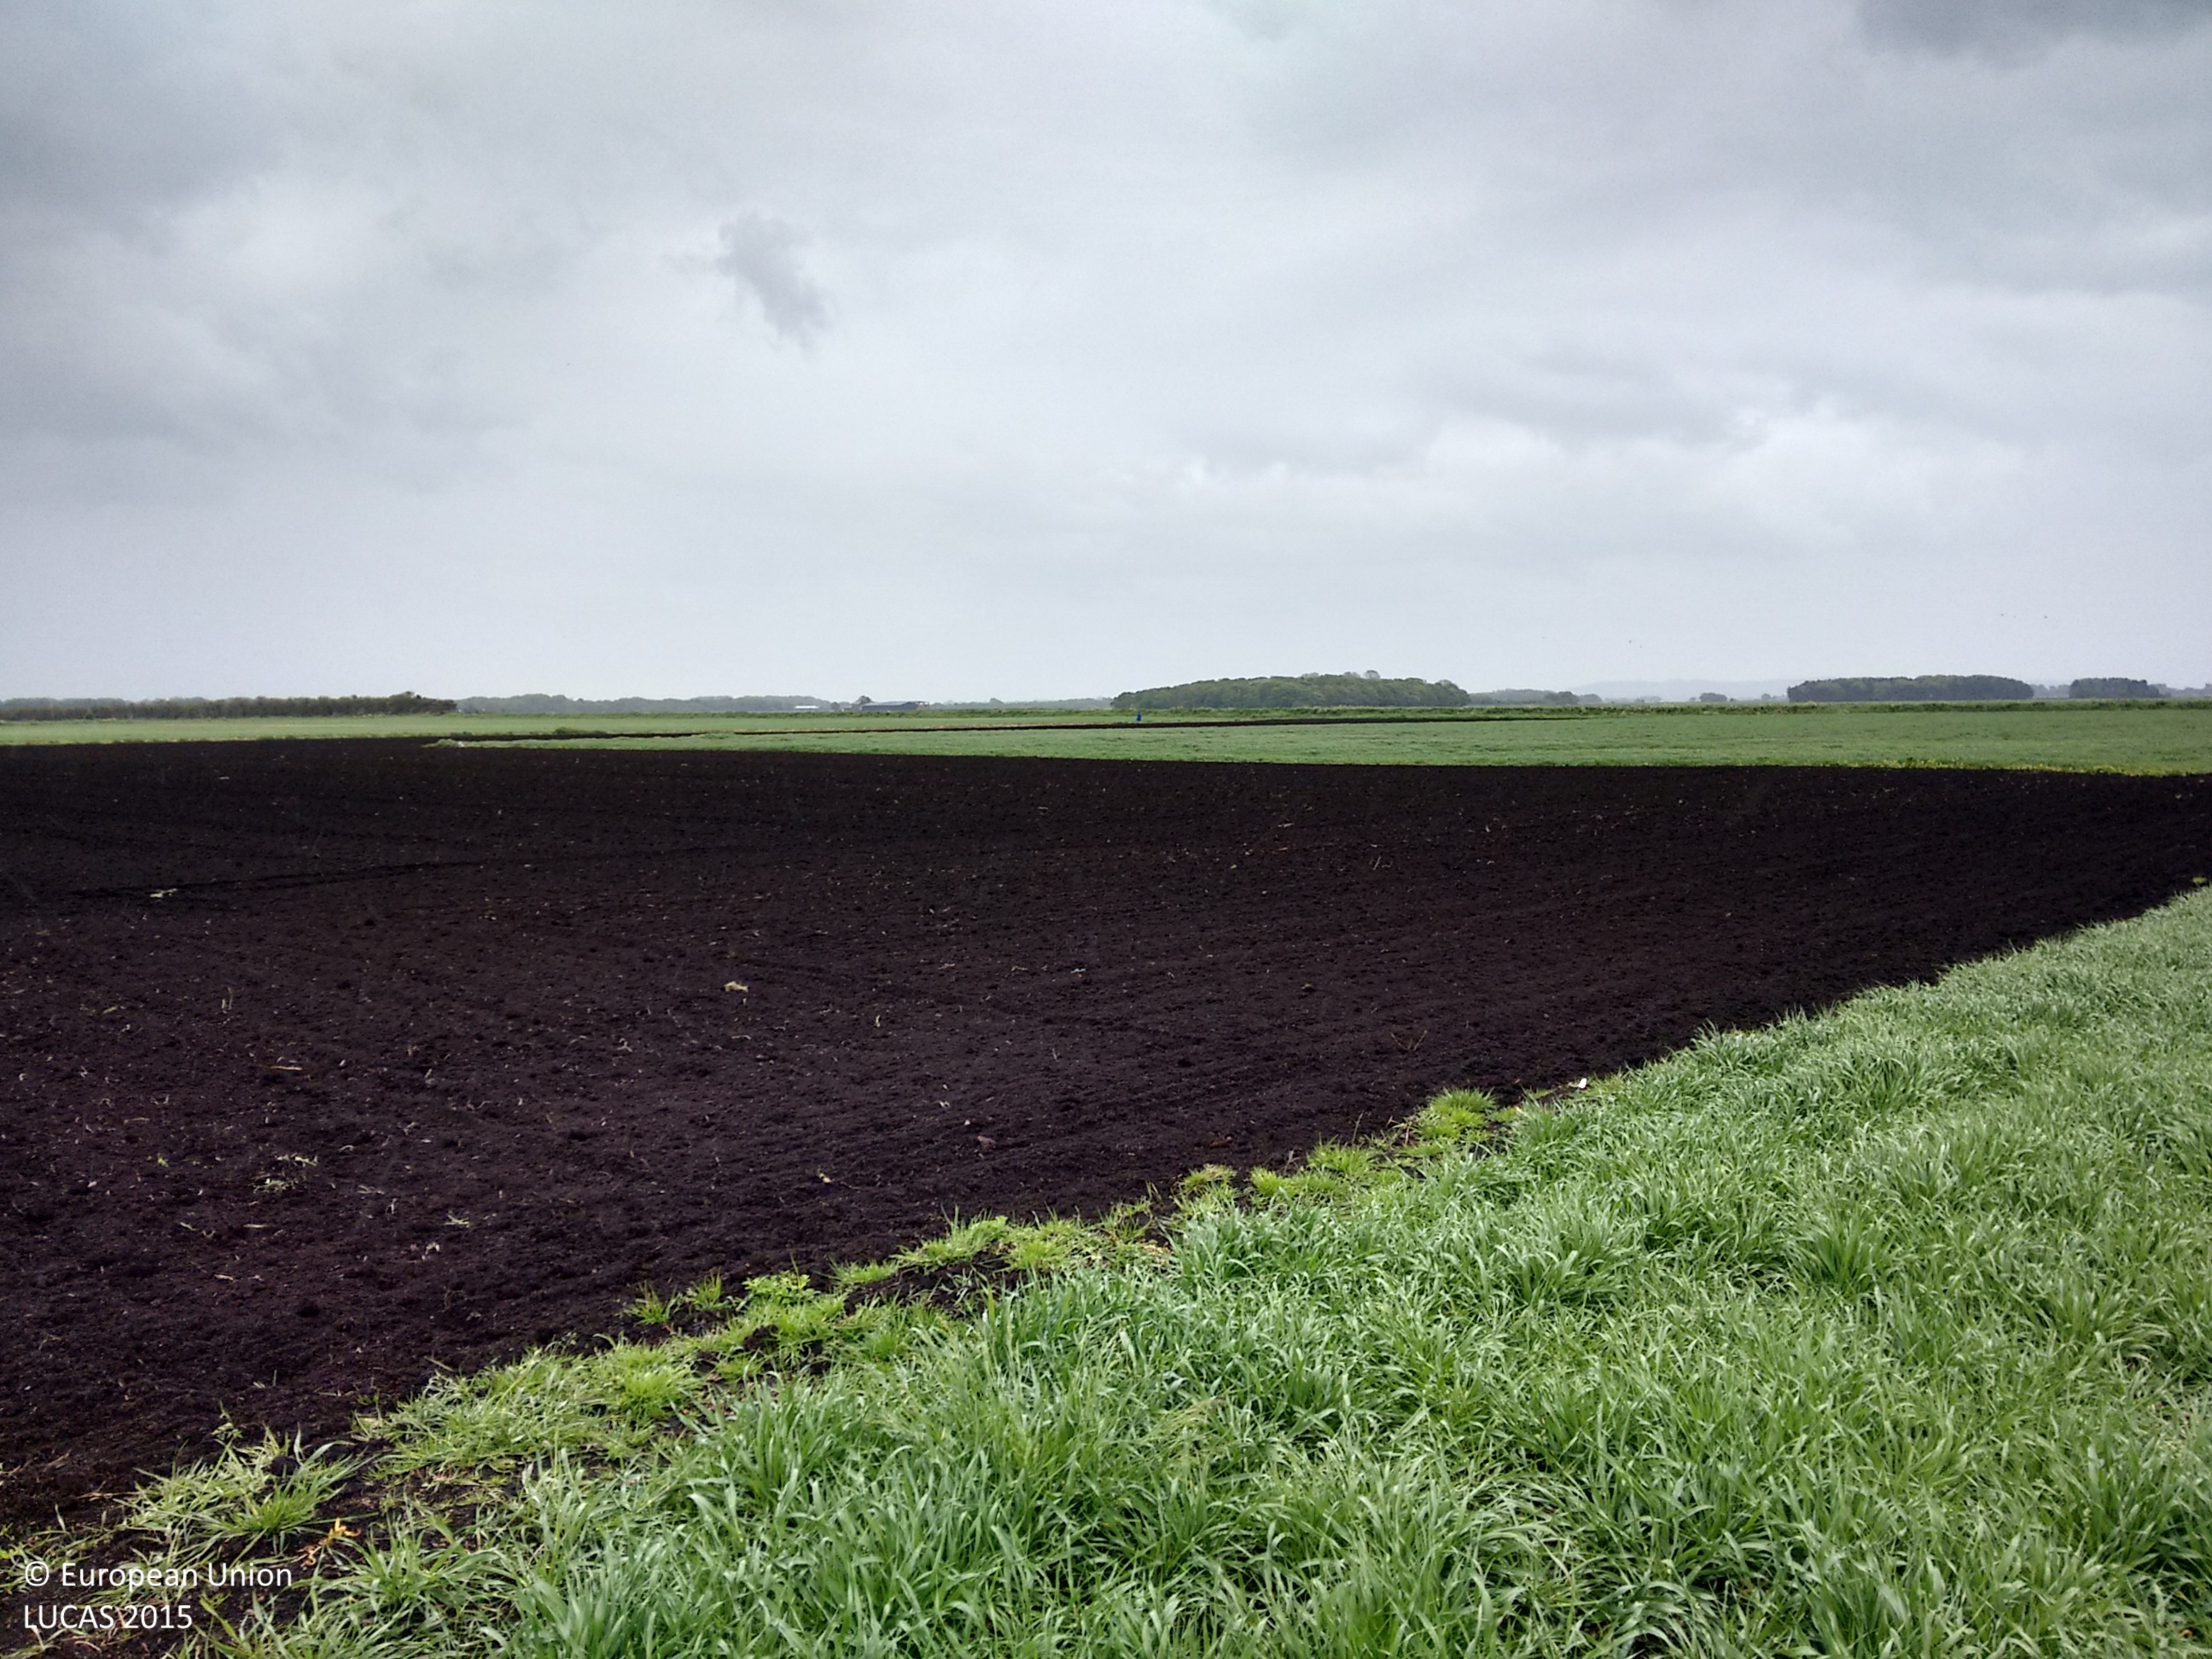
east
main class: Grassland
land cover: Grassland without tree/shrub cover
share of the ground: > 75 %
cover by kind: herbaceous plants 100 %
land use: Agriculture (excluding fallow land and kitchen gardens)
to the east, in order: Grassland without tree/shrub cover; Other bare soil; Temporary grasslands
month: May
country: GB
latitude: 53.6361
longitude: -2.9127
